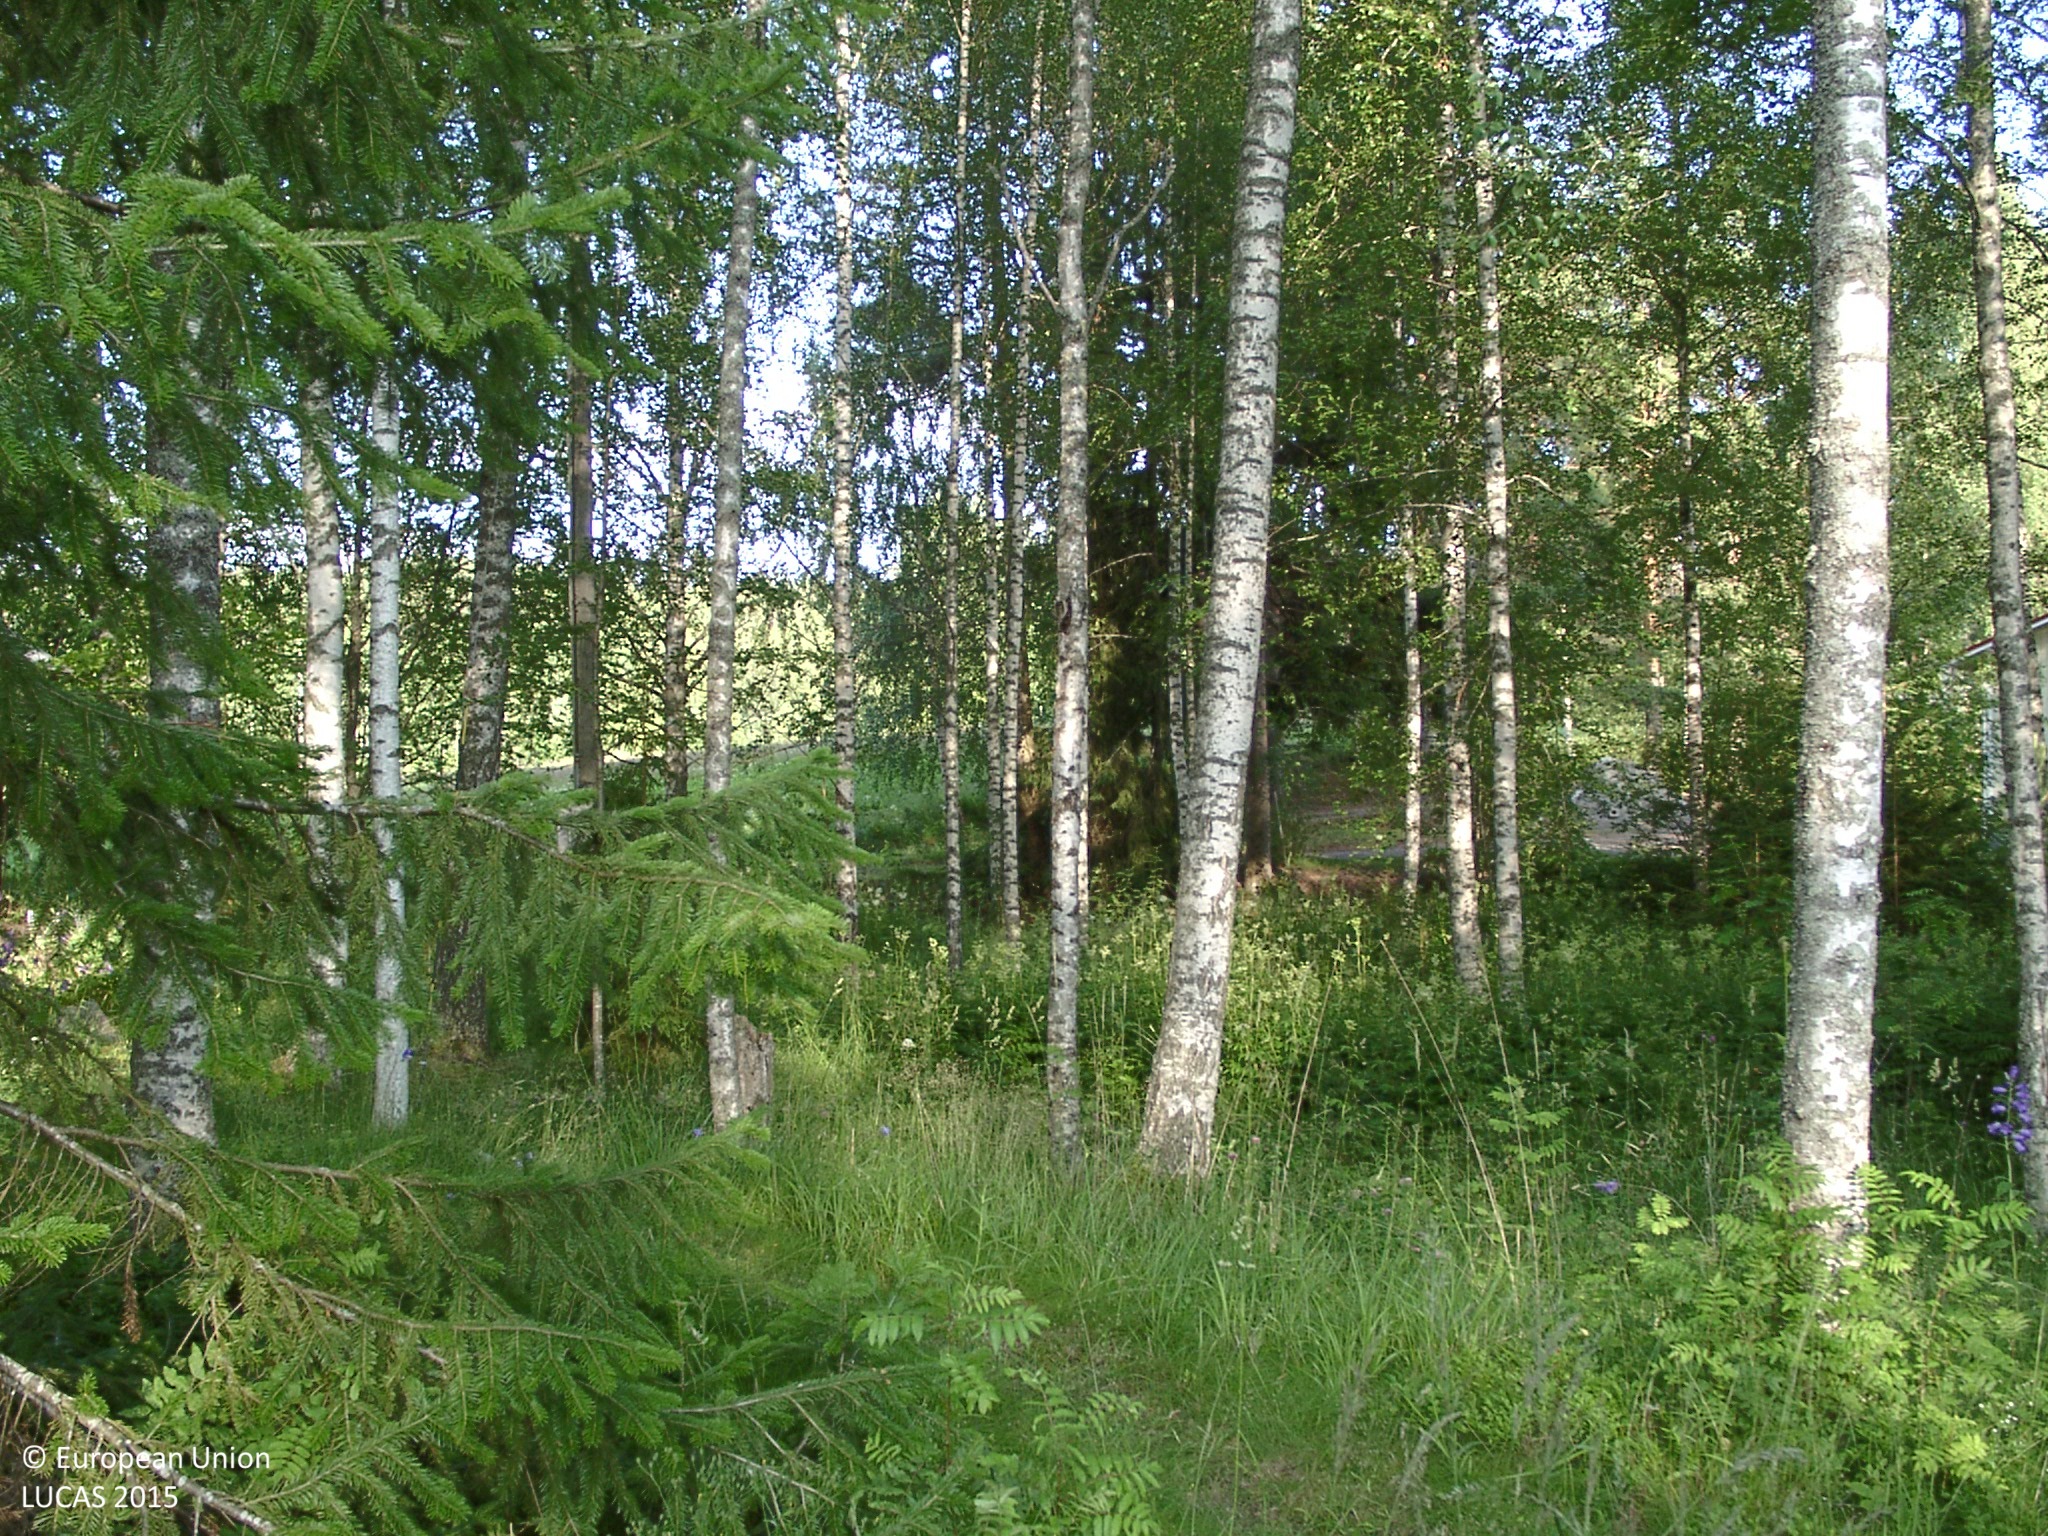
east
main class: Woodland
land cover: Broadleaved woodland
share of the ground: > 75 %
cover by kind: broadleaved forest trees 70 %, herbaceous plants 25 %, coniferous forest trees 5 %
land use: Residential
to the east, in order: Broadleaved woodland; Tracks; Temporary grasslands; Electric lines; Temporary grasslands
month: July
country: FI
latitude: 61.5587
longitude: 25.1898
